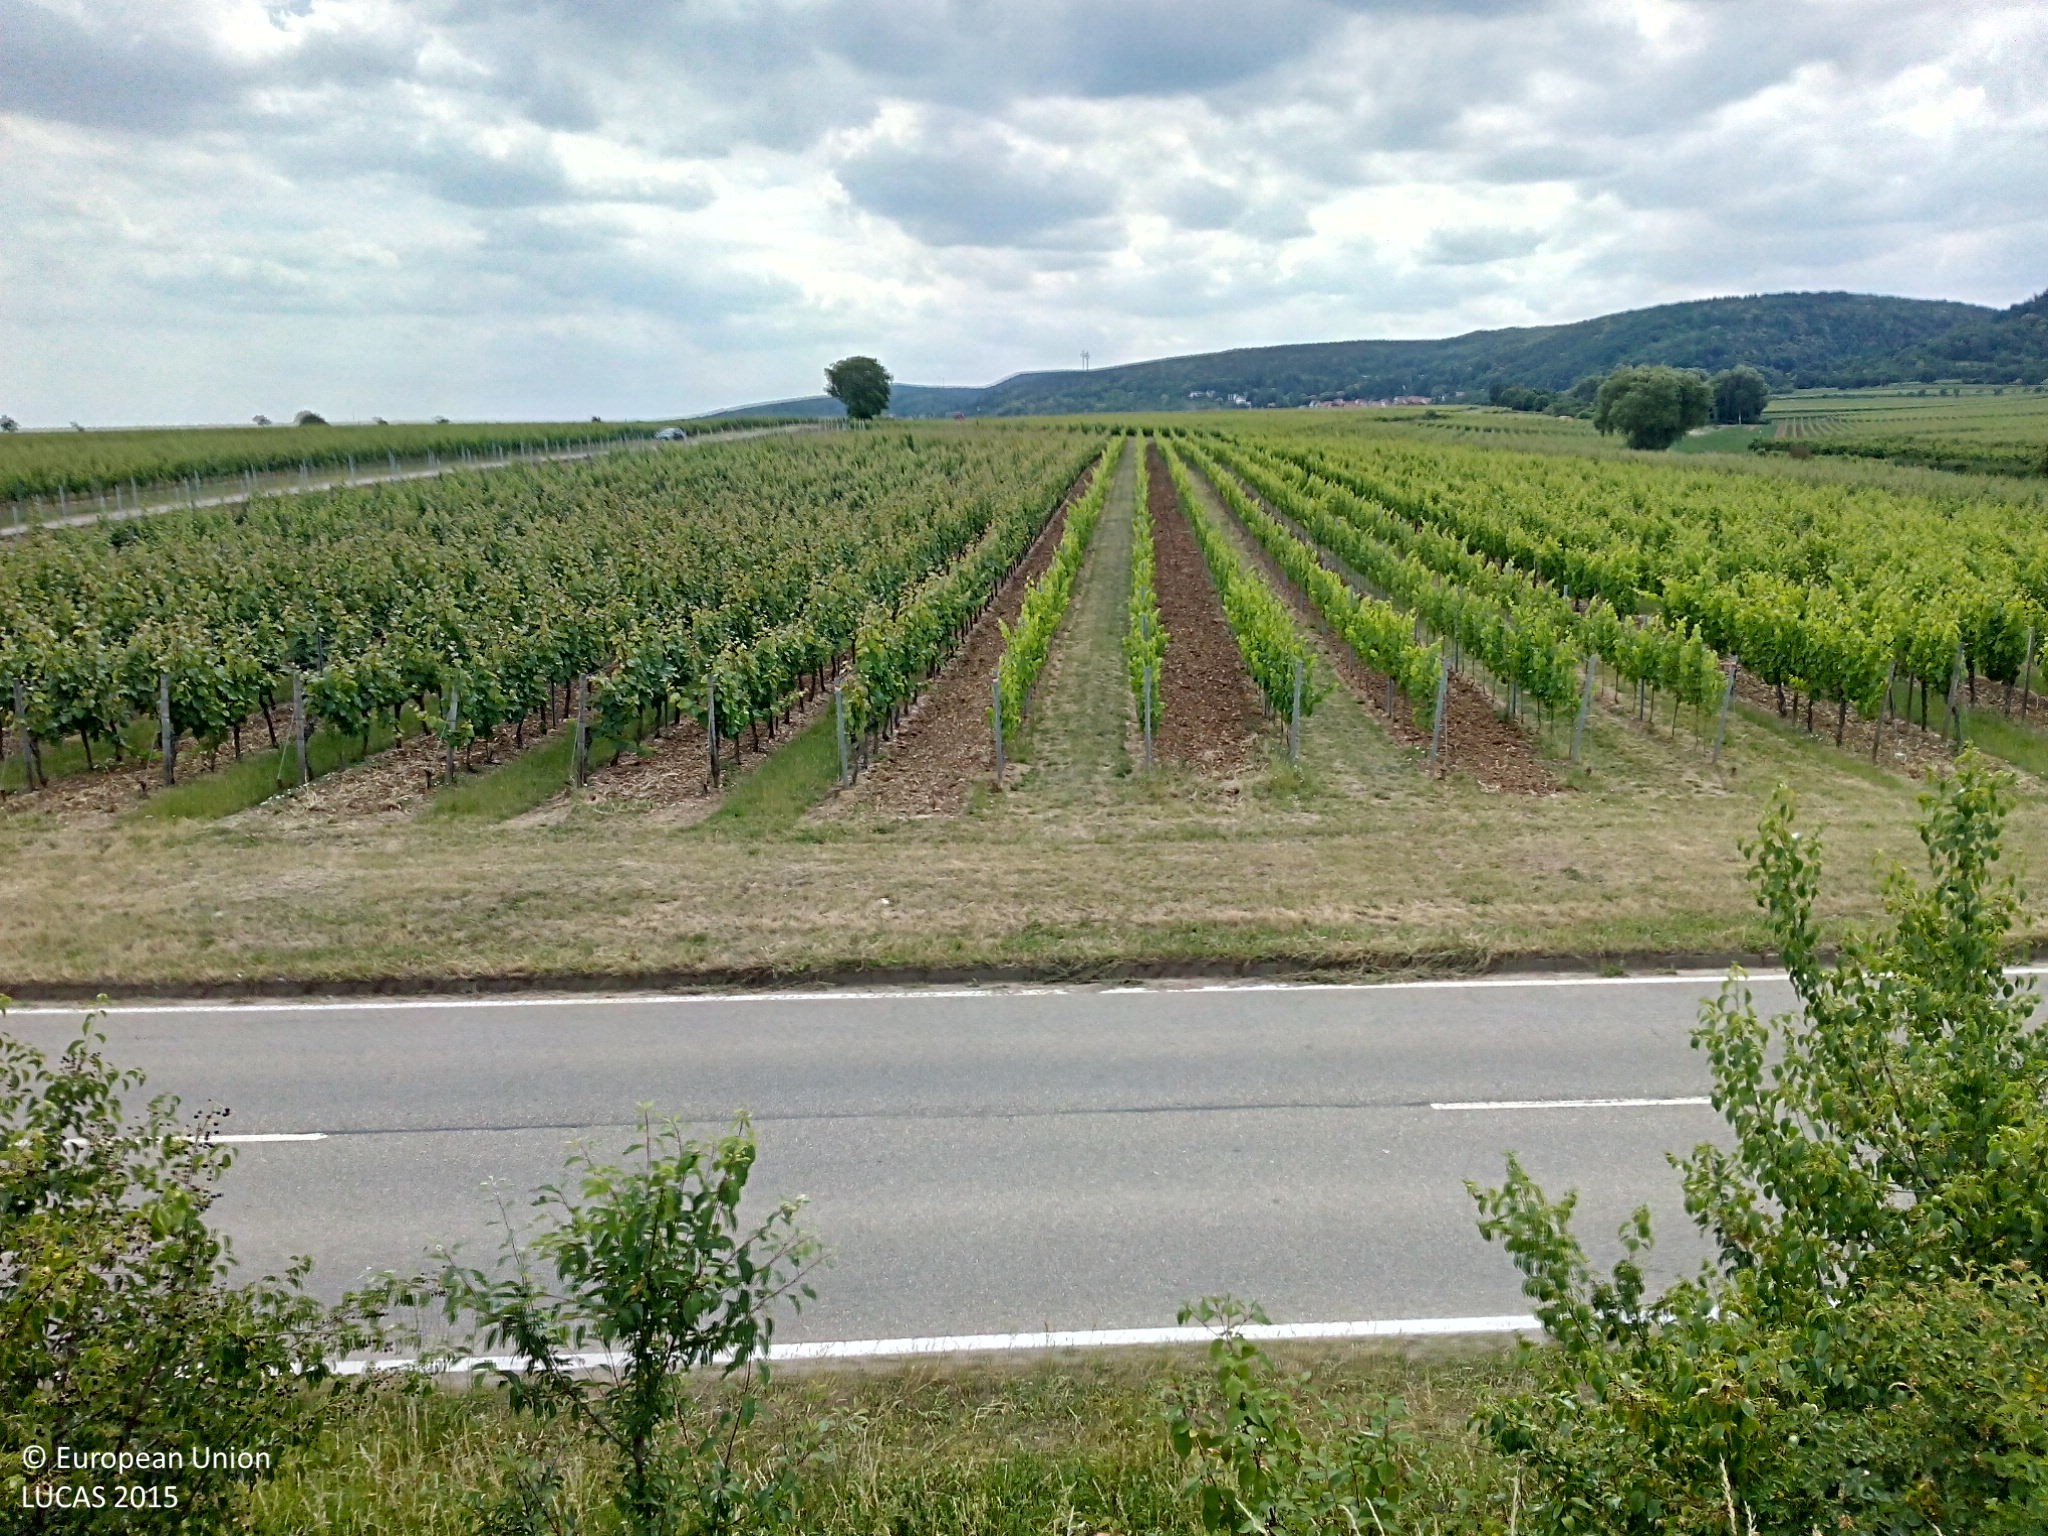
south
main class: Grassland
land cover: Grassland with sparse tree/shrub cover
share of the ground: > 75 %
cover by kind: herbaceous plants 65 %, unconsolidated bare surface 25 %, broadleaved forest trees 5 %, shrubs 5 %
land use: Residential
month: June
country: DE
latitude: 49.5399
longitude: 8.1625
